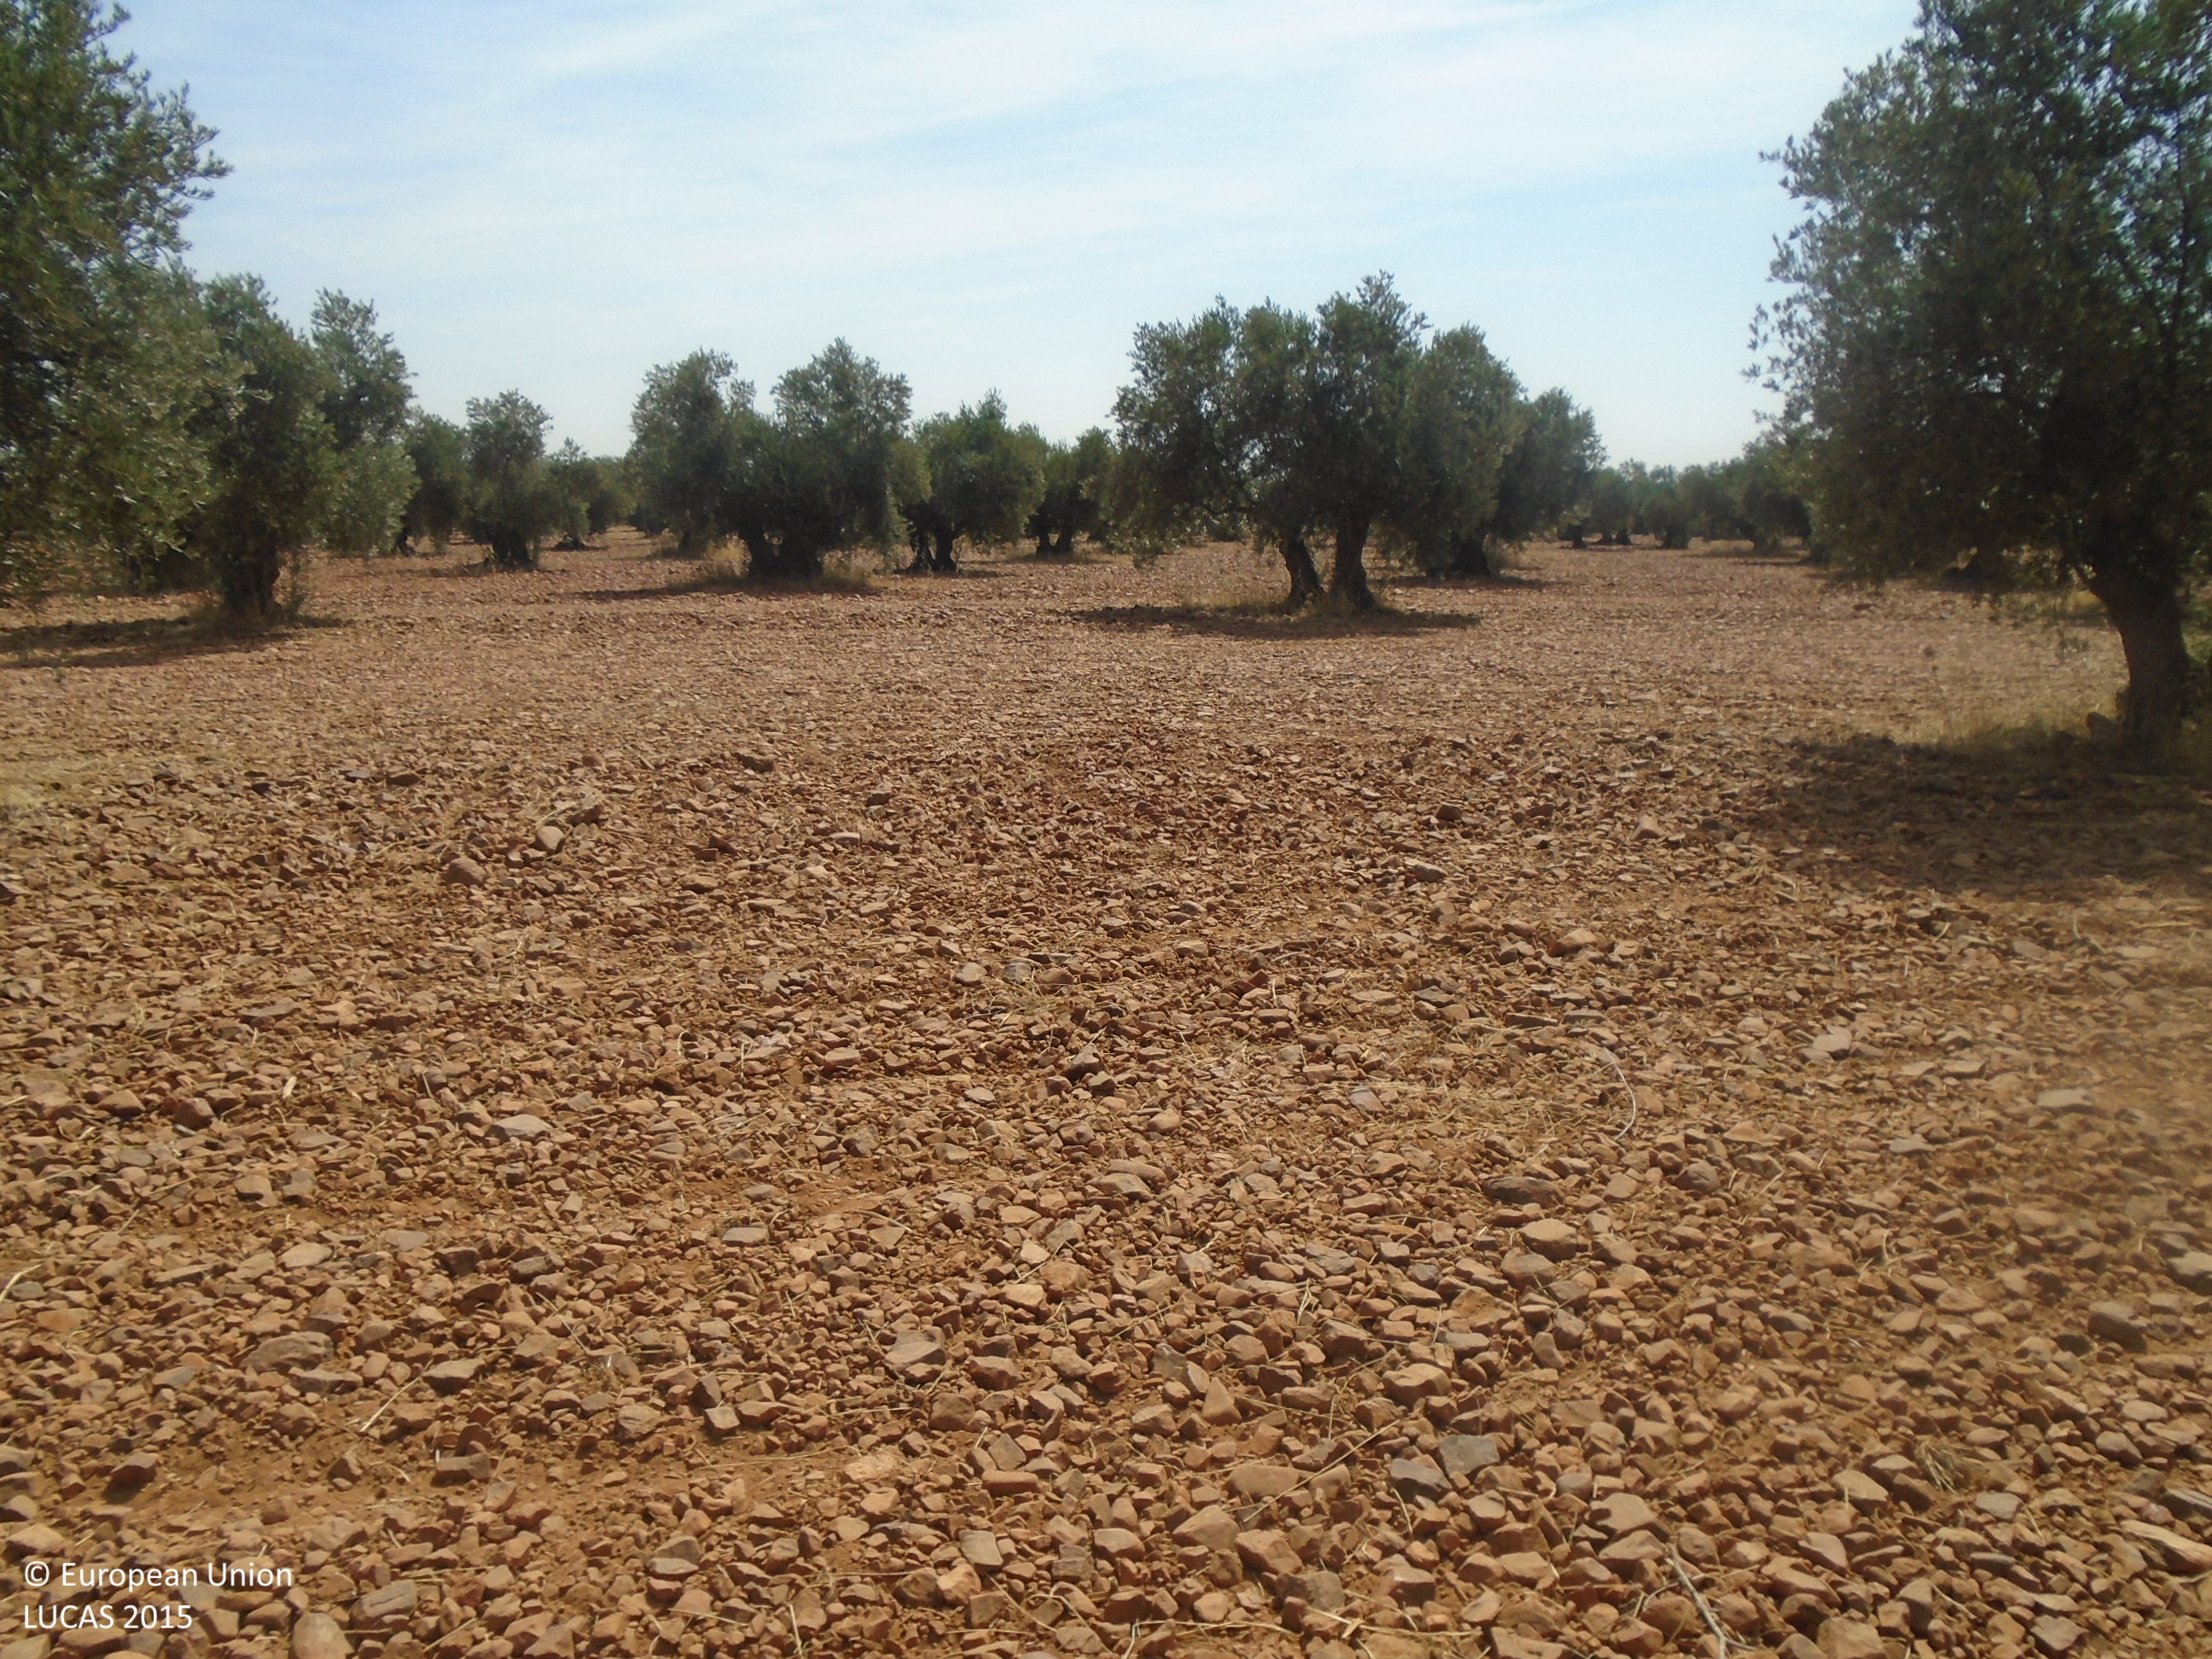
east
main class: Cropland
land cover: Olive groves
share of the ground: 25 - 50 %
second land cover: Other bare soil
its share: > 75 %
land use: Agriculture (excluding fallow land and kitchen gardens)
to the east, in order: Olive groves; Other bare soil; Tracks; Olive groves; Tracks; Olive groves
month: July
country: ES
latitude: 39.3927
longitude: -3.5722
